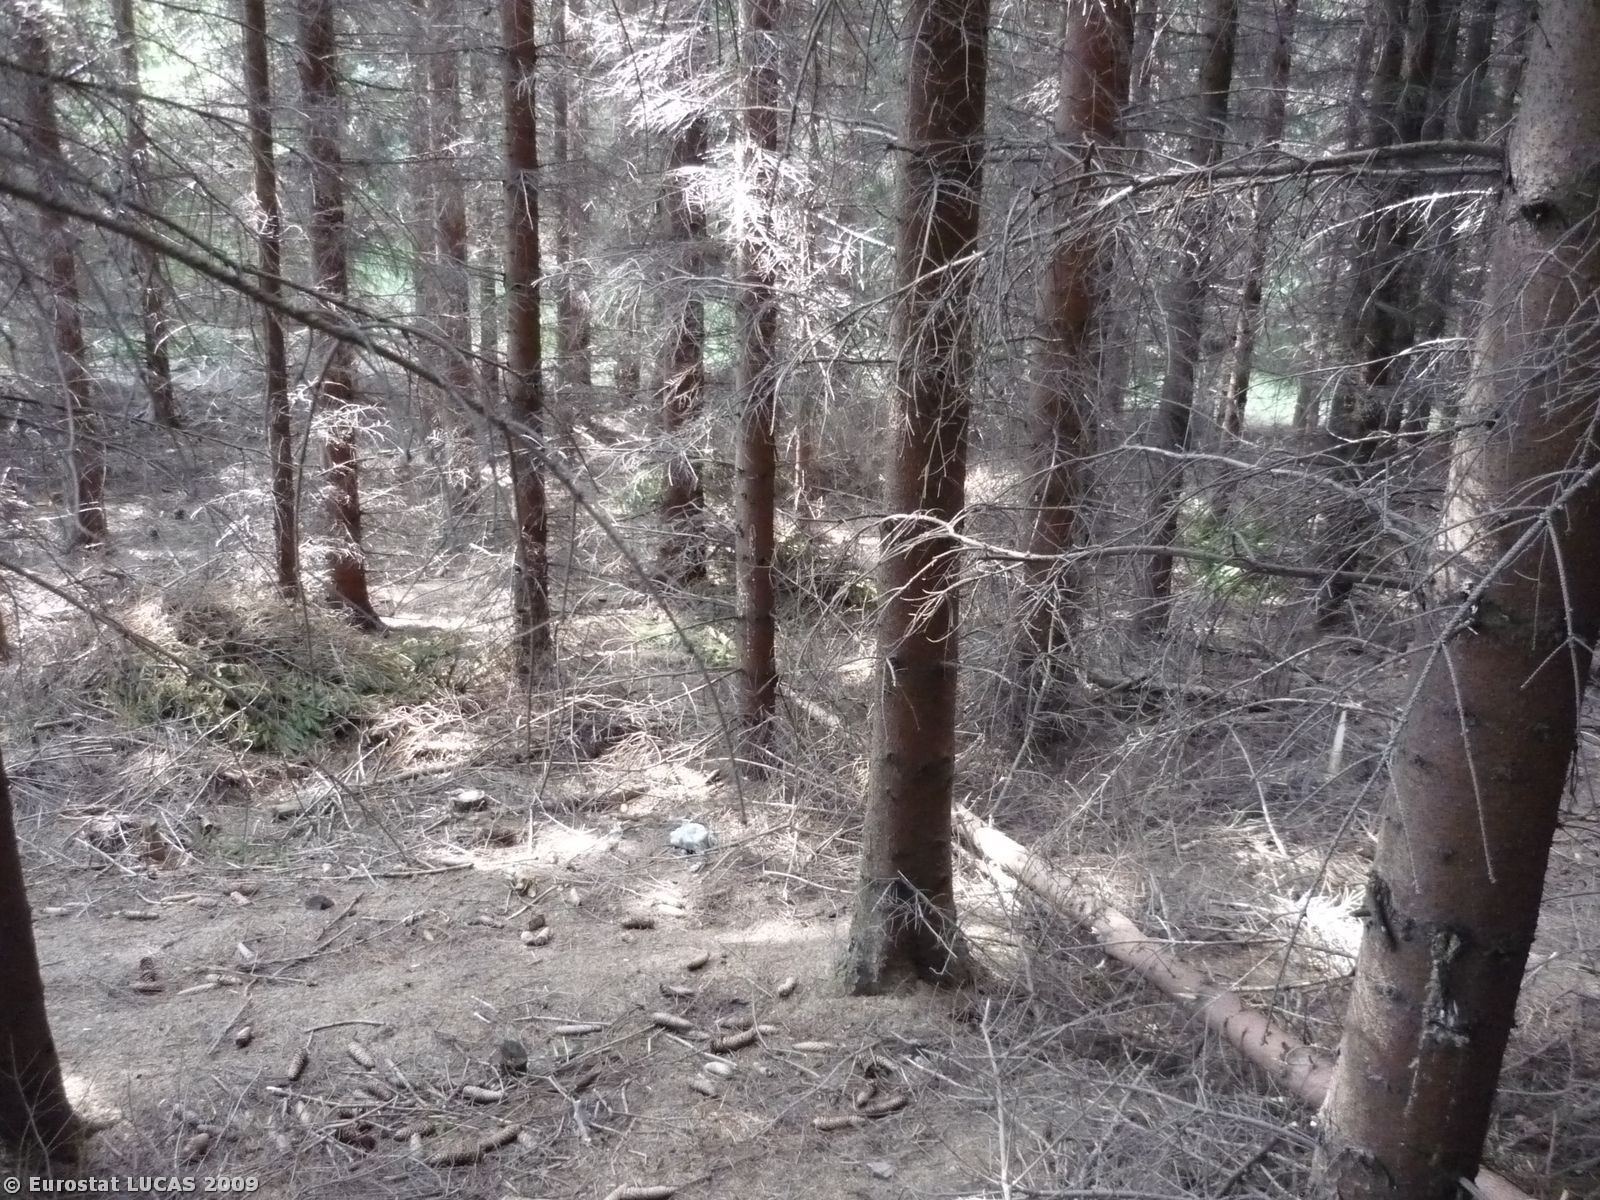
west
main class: Woodland
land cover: Coniferous woodland
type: hemiboreal forest and nemoral coniferous forest and mixed broadleaved-coniferous forest
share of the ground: > 75 %
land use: Forestry
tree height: > 5 m
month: September
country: PL
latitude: 50.7221
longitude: 16.1398
